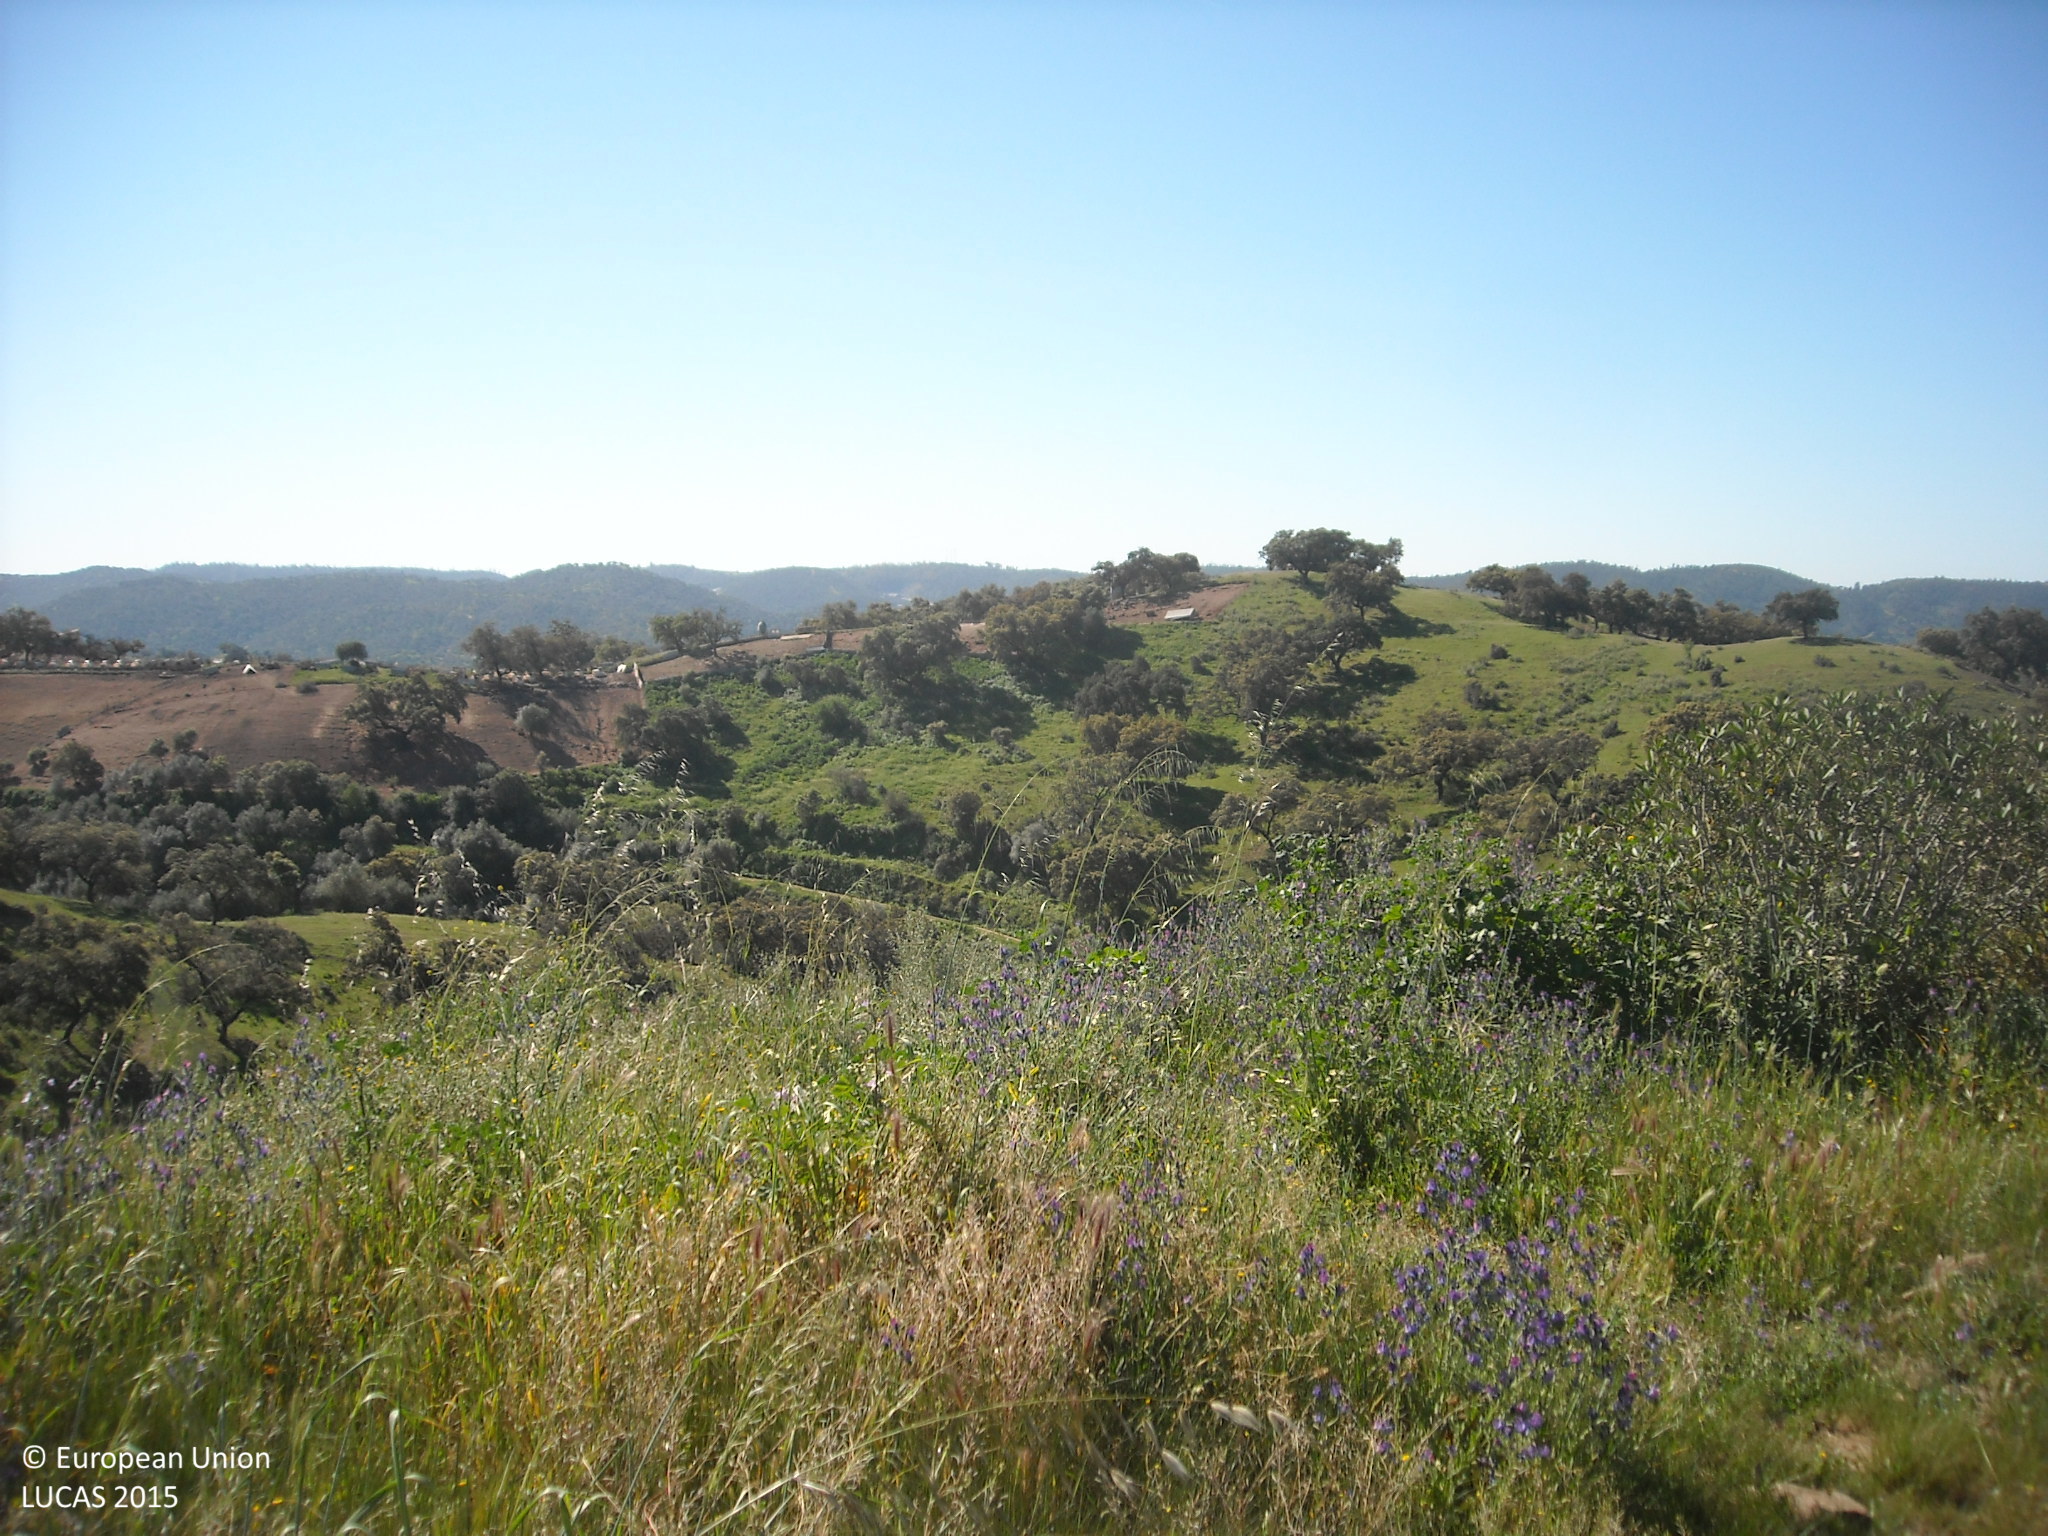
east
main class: Woodland
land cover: Broadleaved woodland
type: broadleaved evergreen forest
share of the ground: 25 - 50 %
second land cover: Grassland without tree/shrub cover
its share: > 75 %
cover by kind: herbaceous plants 60 %, broadleaved forest trees 40 %
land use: Forestry
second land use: Agriculture (excluding fallow land and kitchen gardens)
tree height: > 5 m
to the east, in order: Broadleaved woodland; Grassland without tree/shrub cover; Tracks; Broadleaved woodland; Tracks; Broadleaved woodland
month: April
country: ES
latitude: 37.6997
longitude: -6.1720
